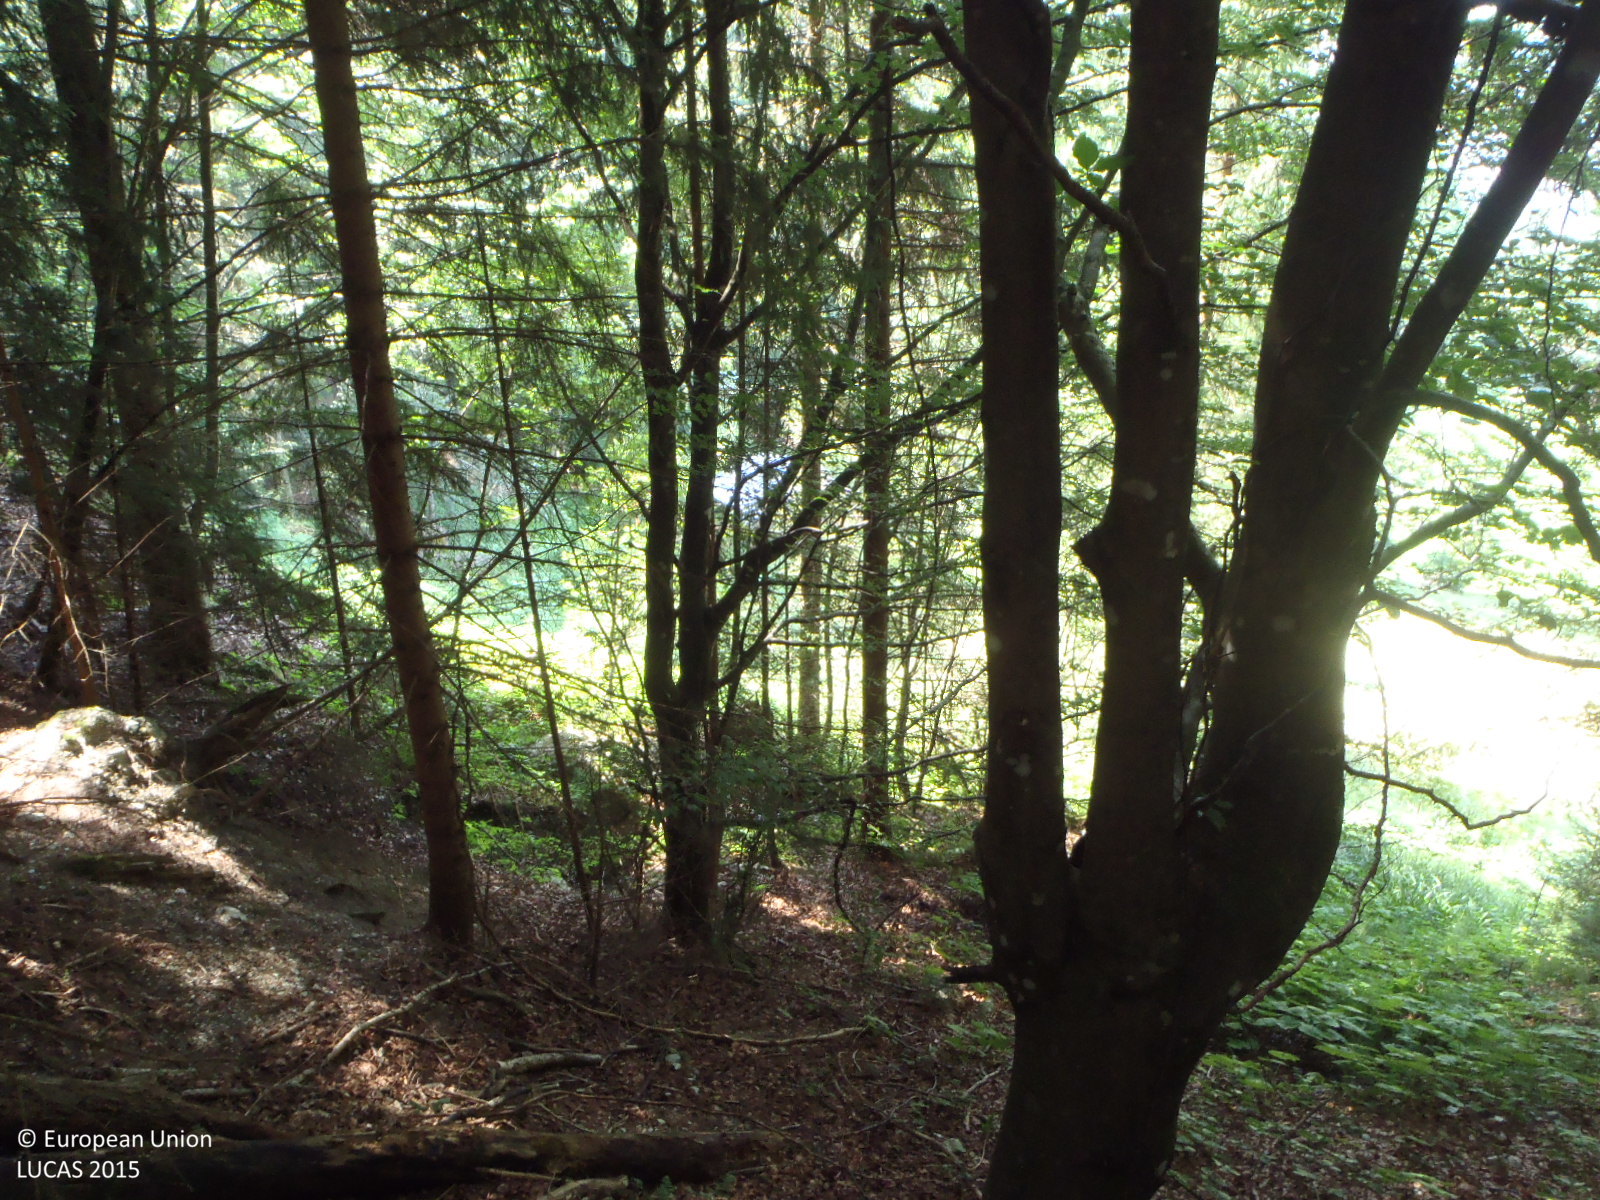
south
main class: Woodland
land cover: Spruce dominated mixed woodland
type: alpine coniferous forest
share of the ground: > 75 %
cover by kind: coniferous forest trees 60 %, broadleaved forest trees 30 %, shrubs 10 %
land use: Forestry
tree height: > 5 m
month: July
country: AT
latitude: 47.4592
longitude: 12.3993
